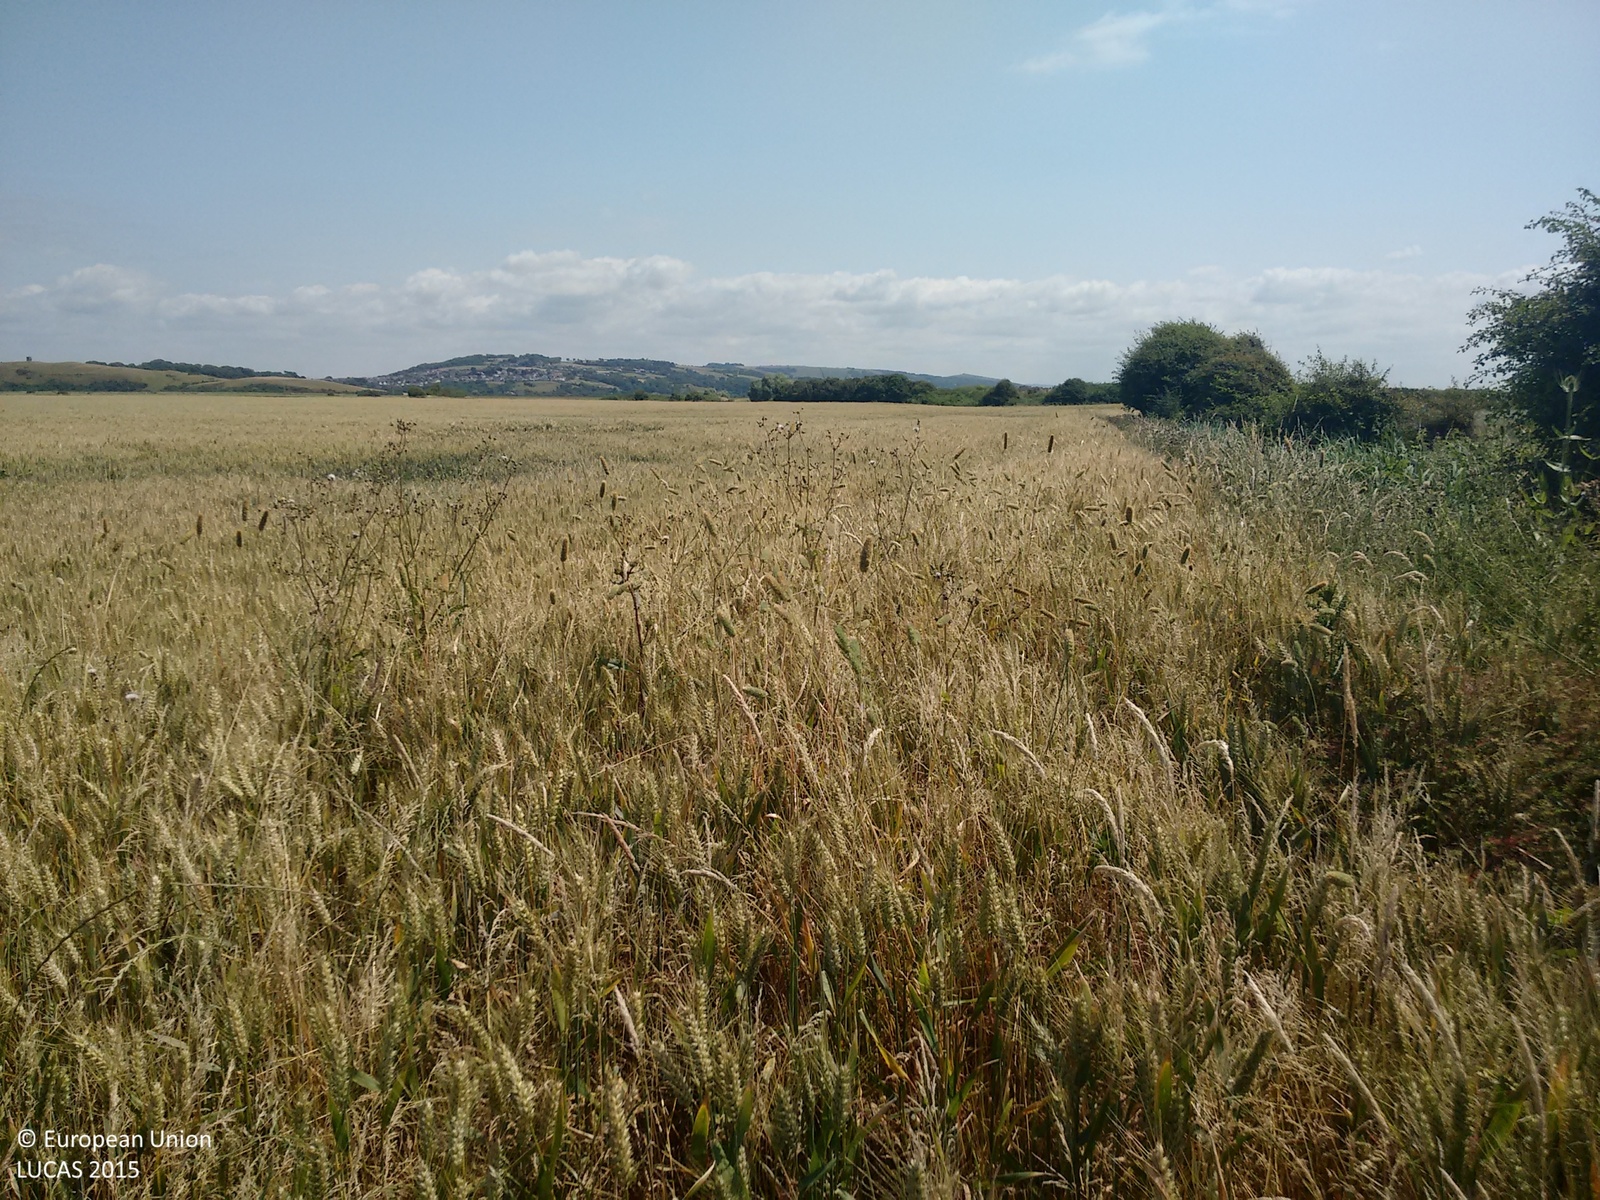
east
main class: Cropland
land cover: Common wheat
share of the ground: > 75 %
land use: Agriculture (excluding fallow land and kitchen gardens)
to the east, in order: Common wheat; Tracks; Ditches and canals; Arable land (only in case pi)
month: July
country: GB
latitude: 51.3124
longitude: -3.0013
